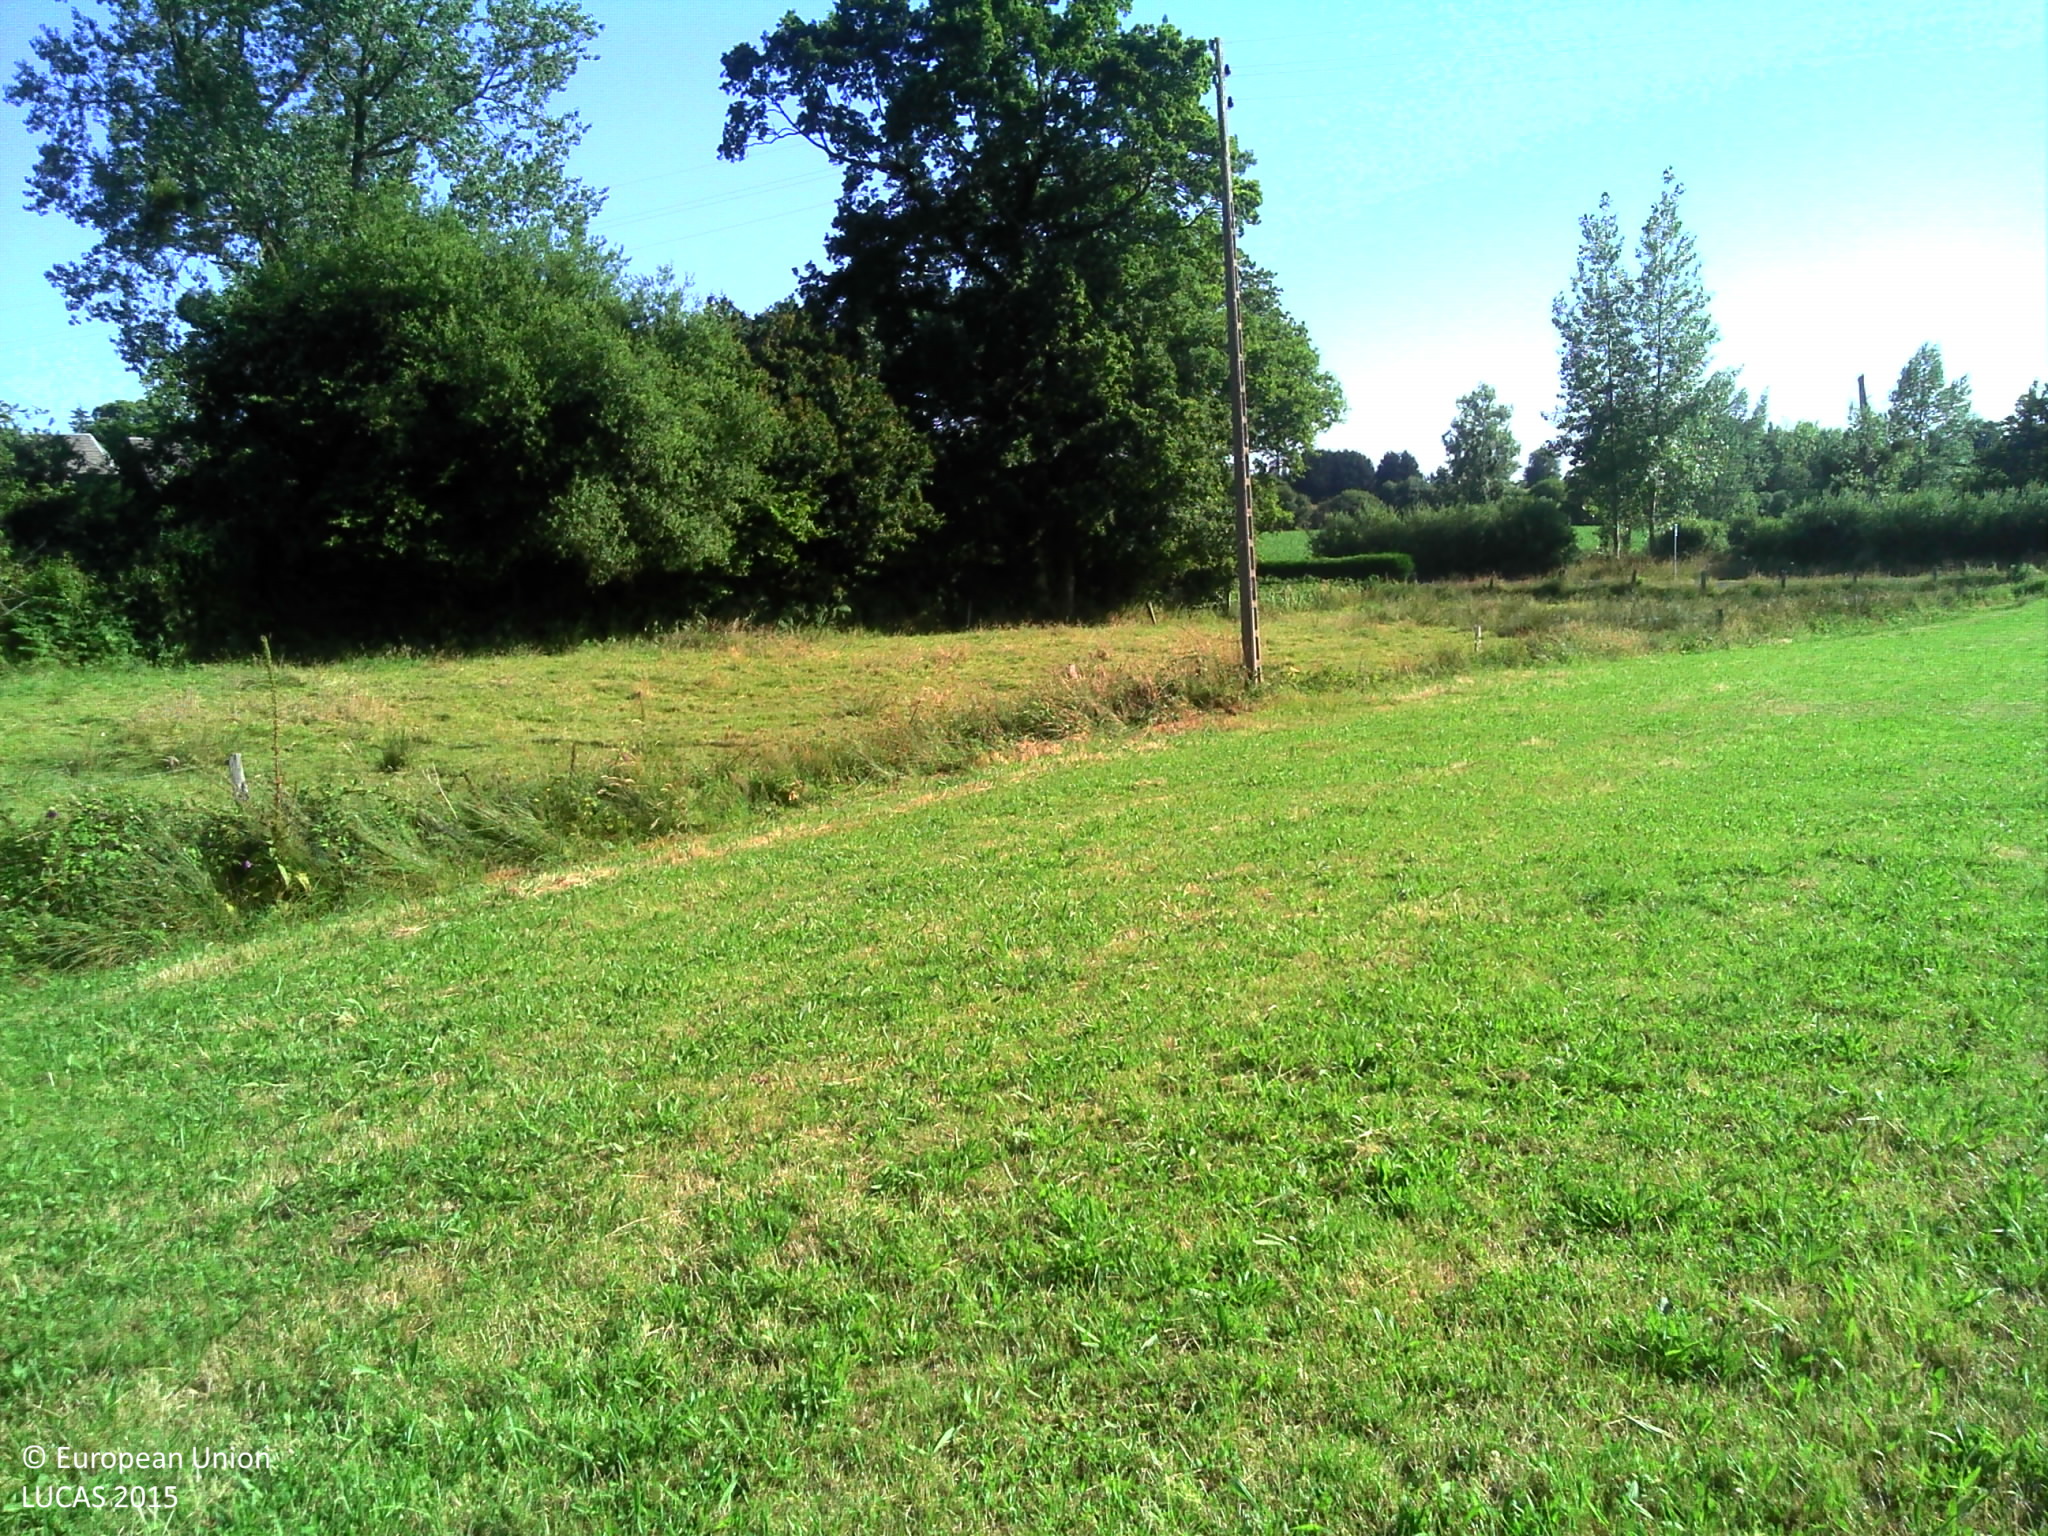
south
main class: Grassland
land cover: Grassland without tree/shrub cover
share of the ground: > 75 %
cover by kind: herbaceous plants 100 %
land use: Agriculture (excluding fallow land and kitchen gardens)
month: July
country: FR
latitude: 49.0156
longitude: -1.3542
